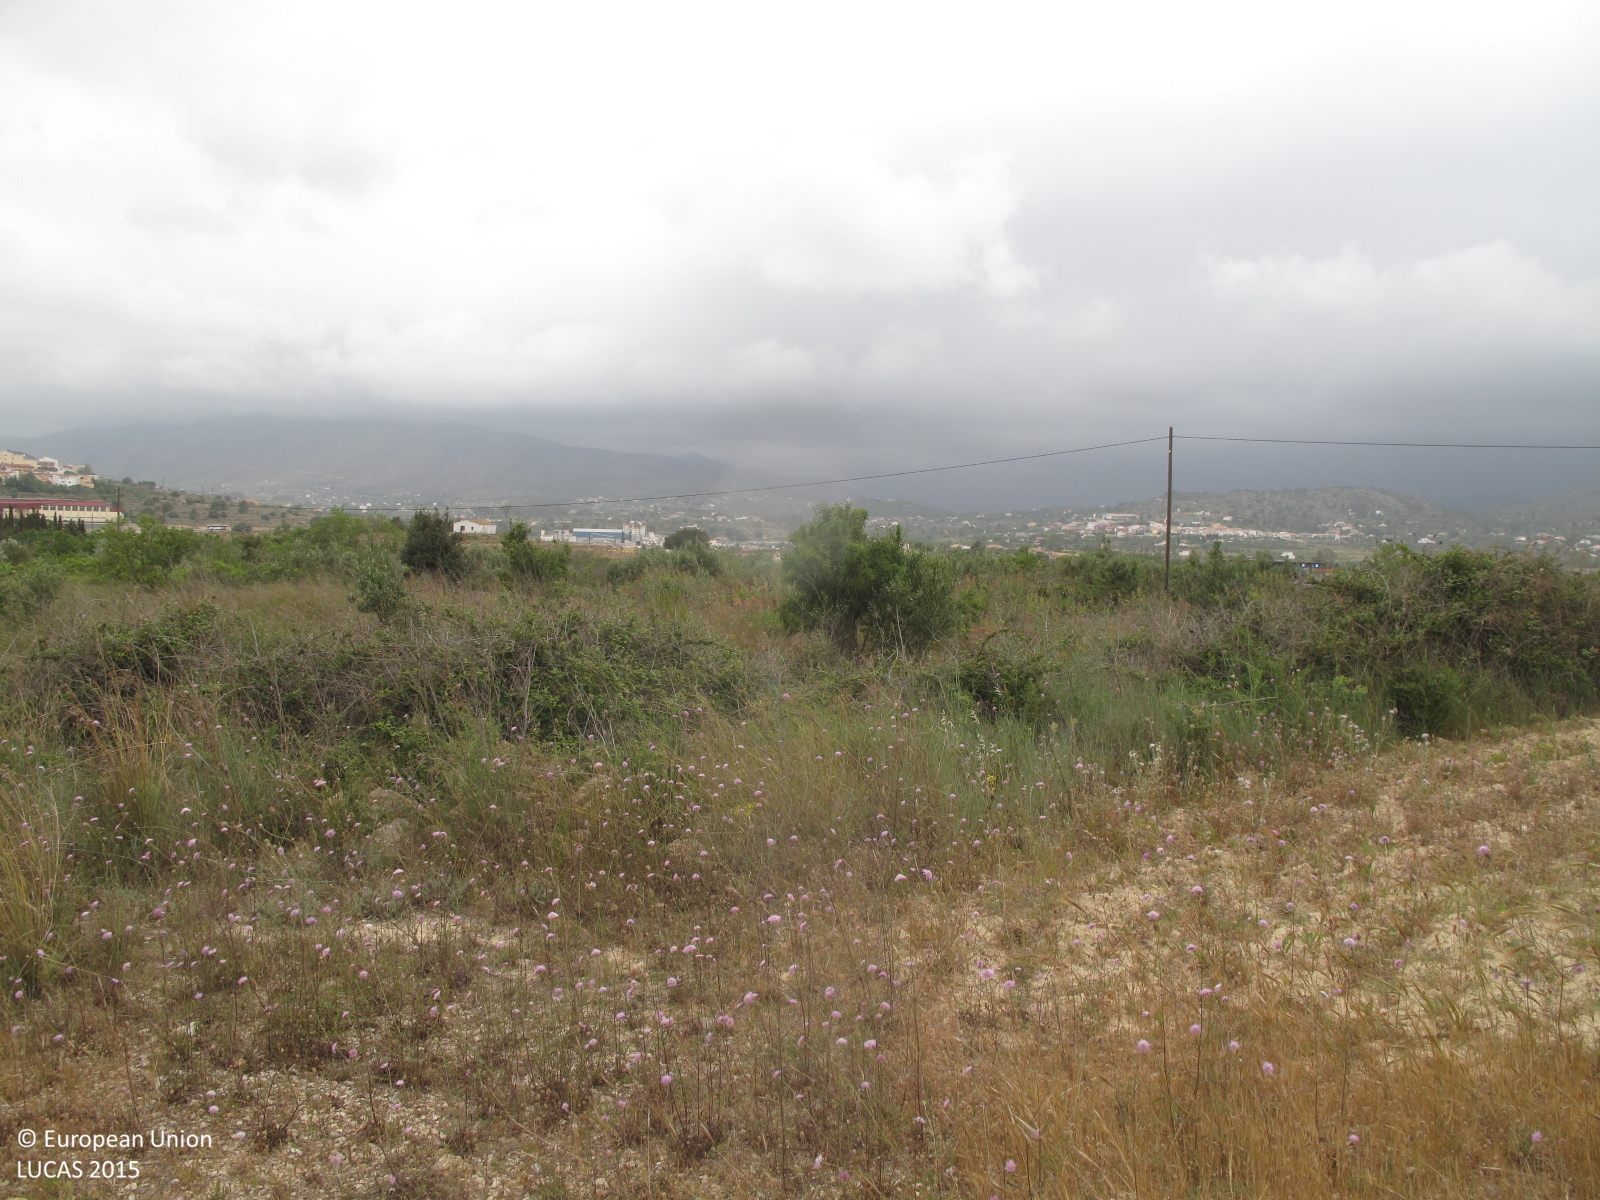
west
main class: Grassland
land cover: Grassland without tree/shrub cover
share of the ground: > 75 %
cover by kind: herbaceous plants 100 %
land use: Semi-natural and natural areas not in use
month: May
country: ES
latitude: 38.7225
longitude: 0.0631
